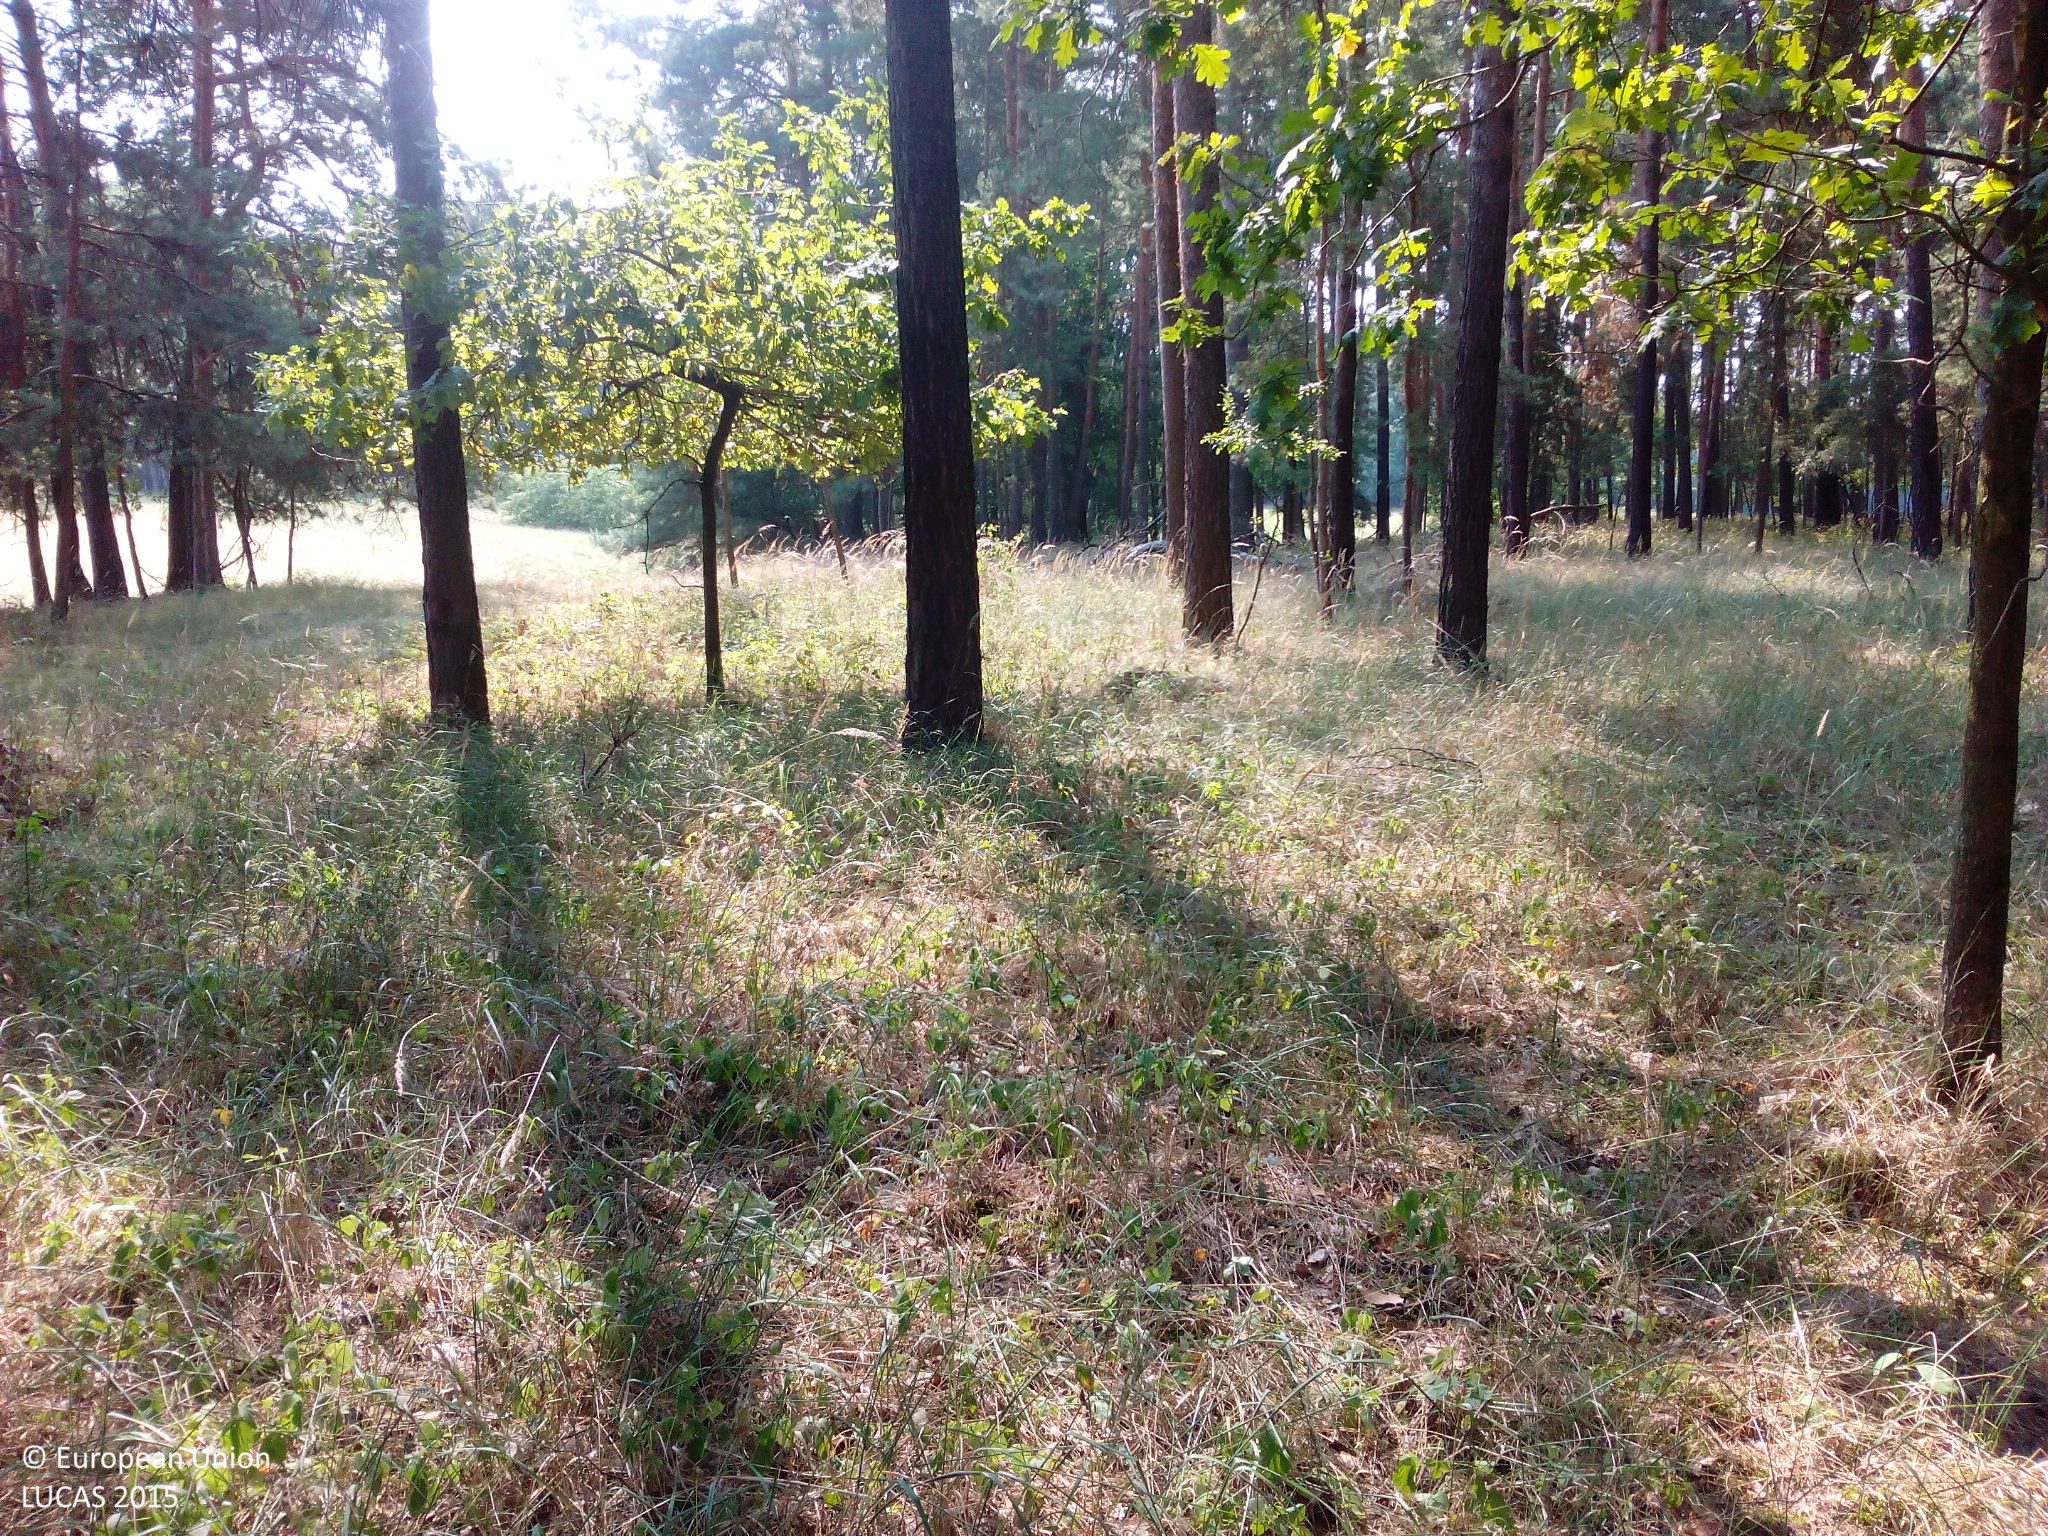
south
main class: Woodland
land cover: Pine dominated coniferous woodland
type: hemiboreal forest and nemoral coniferous forest and mixed broadleaved-coniferous forest
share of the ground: > 75 %
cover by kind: coniferous forest trees 95 %, herbaceous plants 5 %
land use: Forestry
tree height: > 5 m
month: August
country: DE
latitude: 51.7563
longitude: 12.5640
